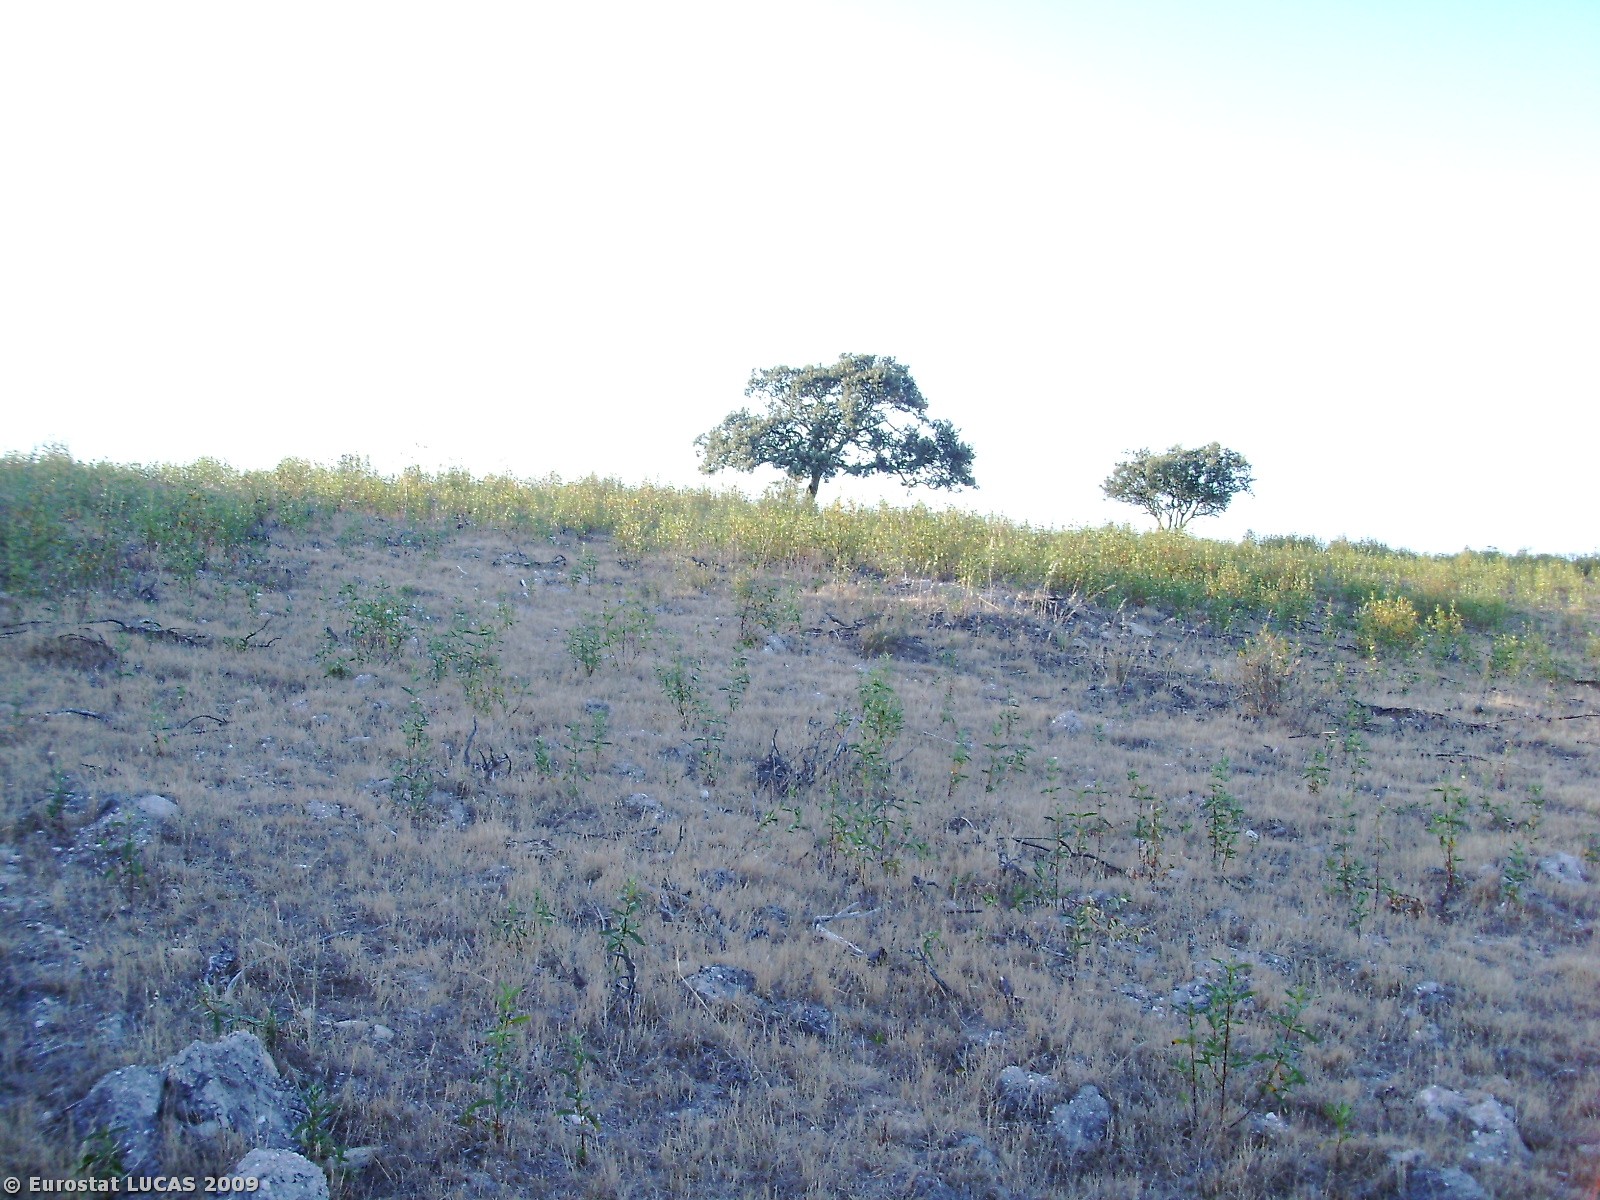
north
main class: Grassland
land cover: Spontaneously vegetated surfaces
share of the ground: 50 - 75 %
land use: Fallow land
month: June
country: PT
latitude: 38.1046
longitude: -8.4854
